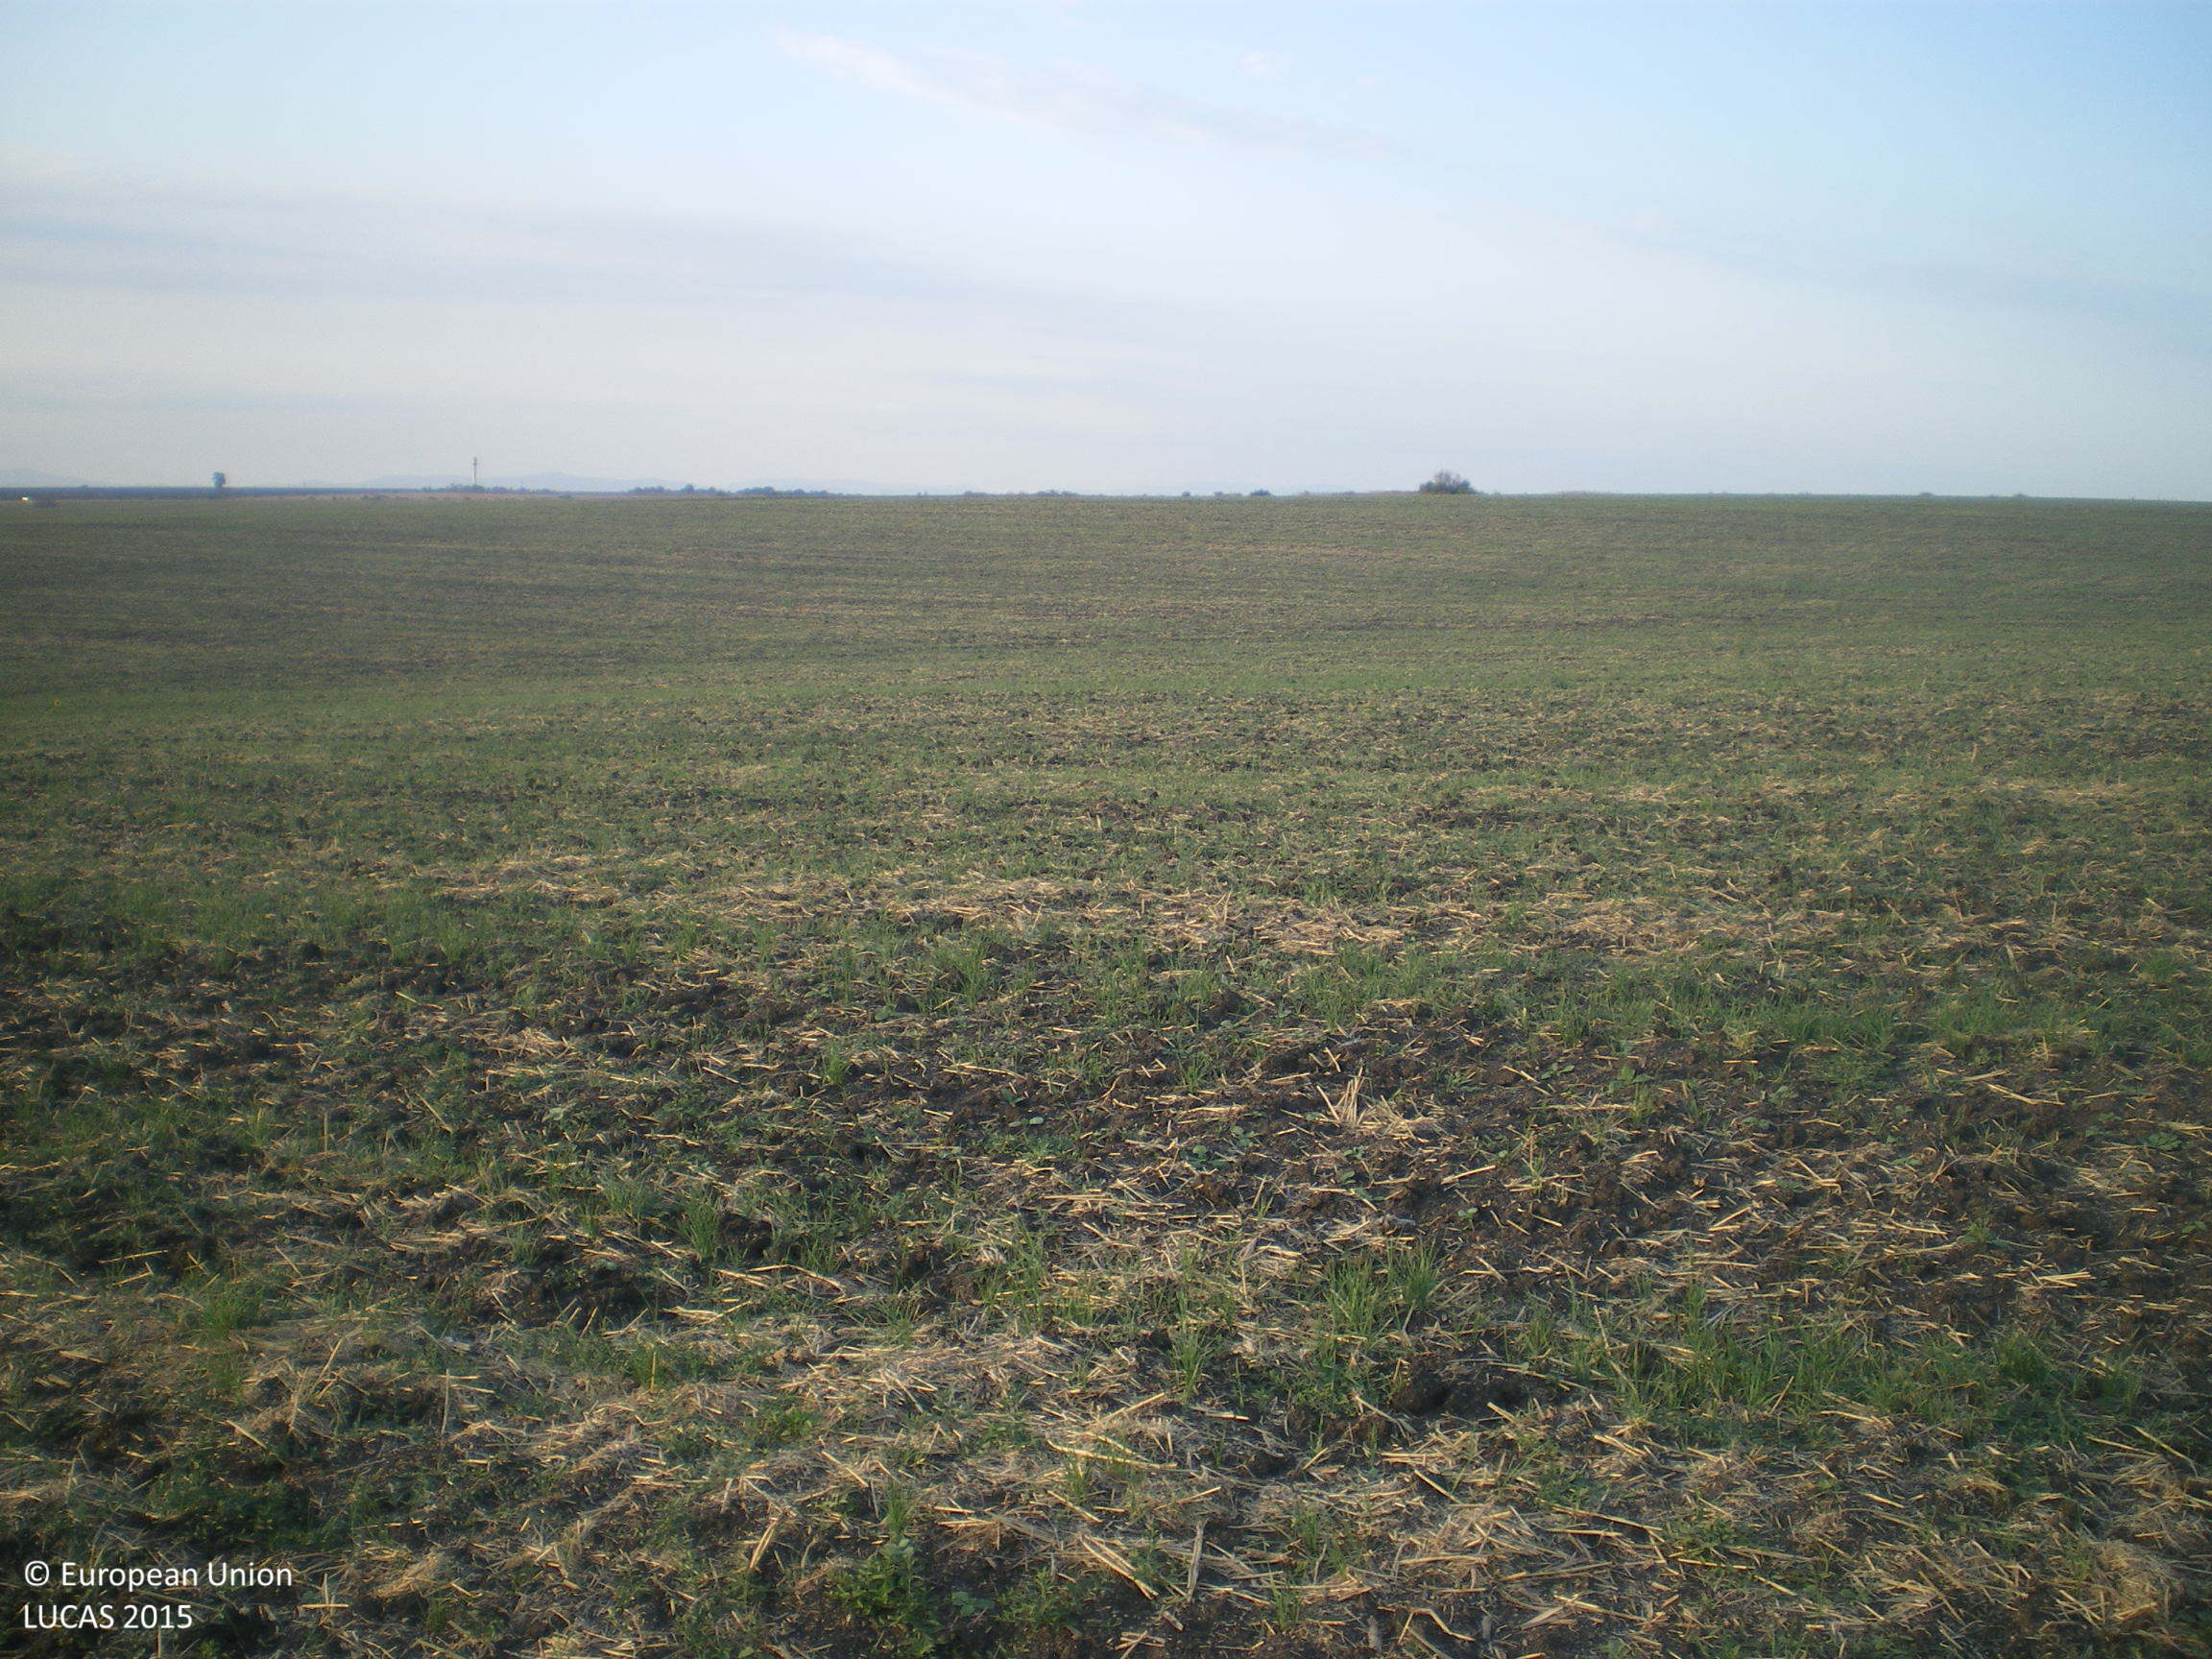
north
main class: Cropland
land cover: Common wheat
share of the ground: < 10 %
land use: Agriculture (excluding fallow land and kitchen gardens)
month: September
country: BG
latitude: 42.1588
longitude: 25.7938
